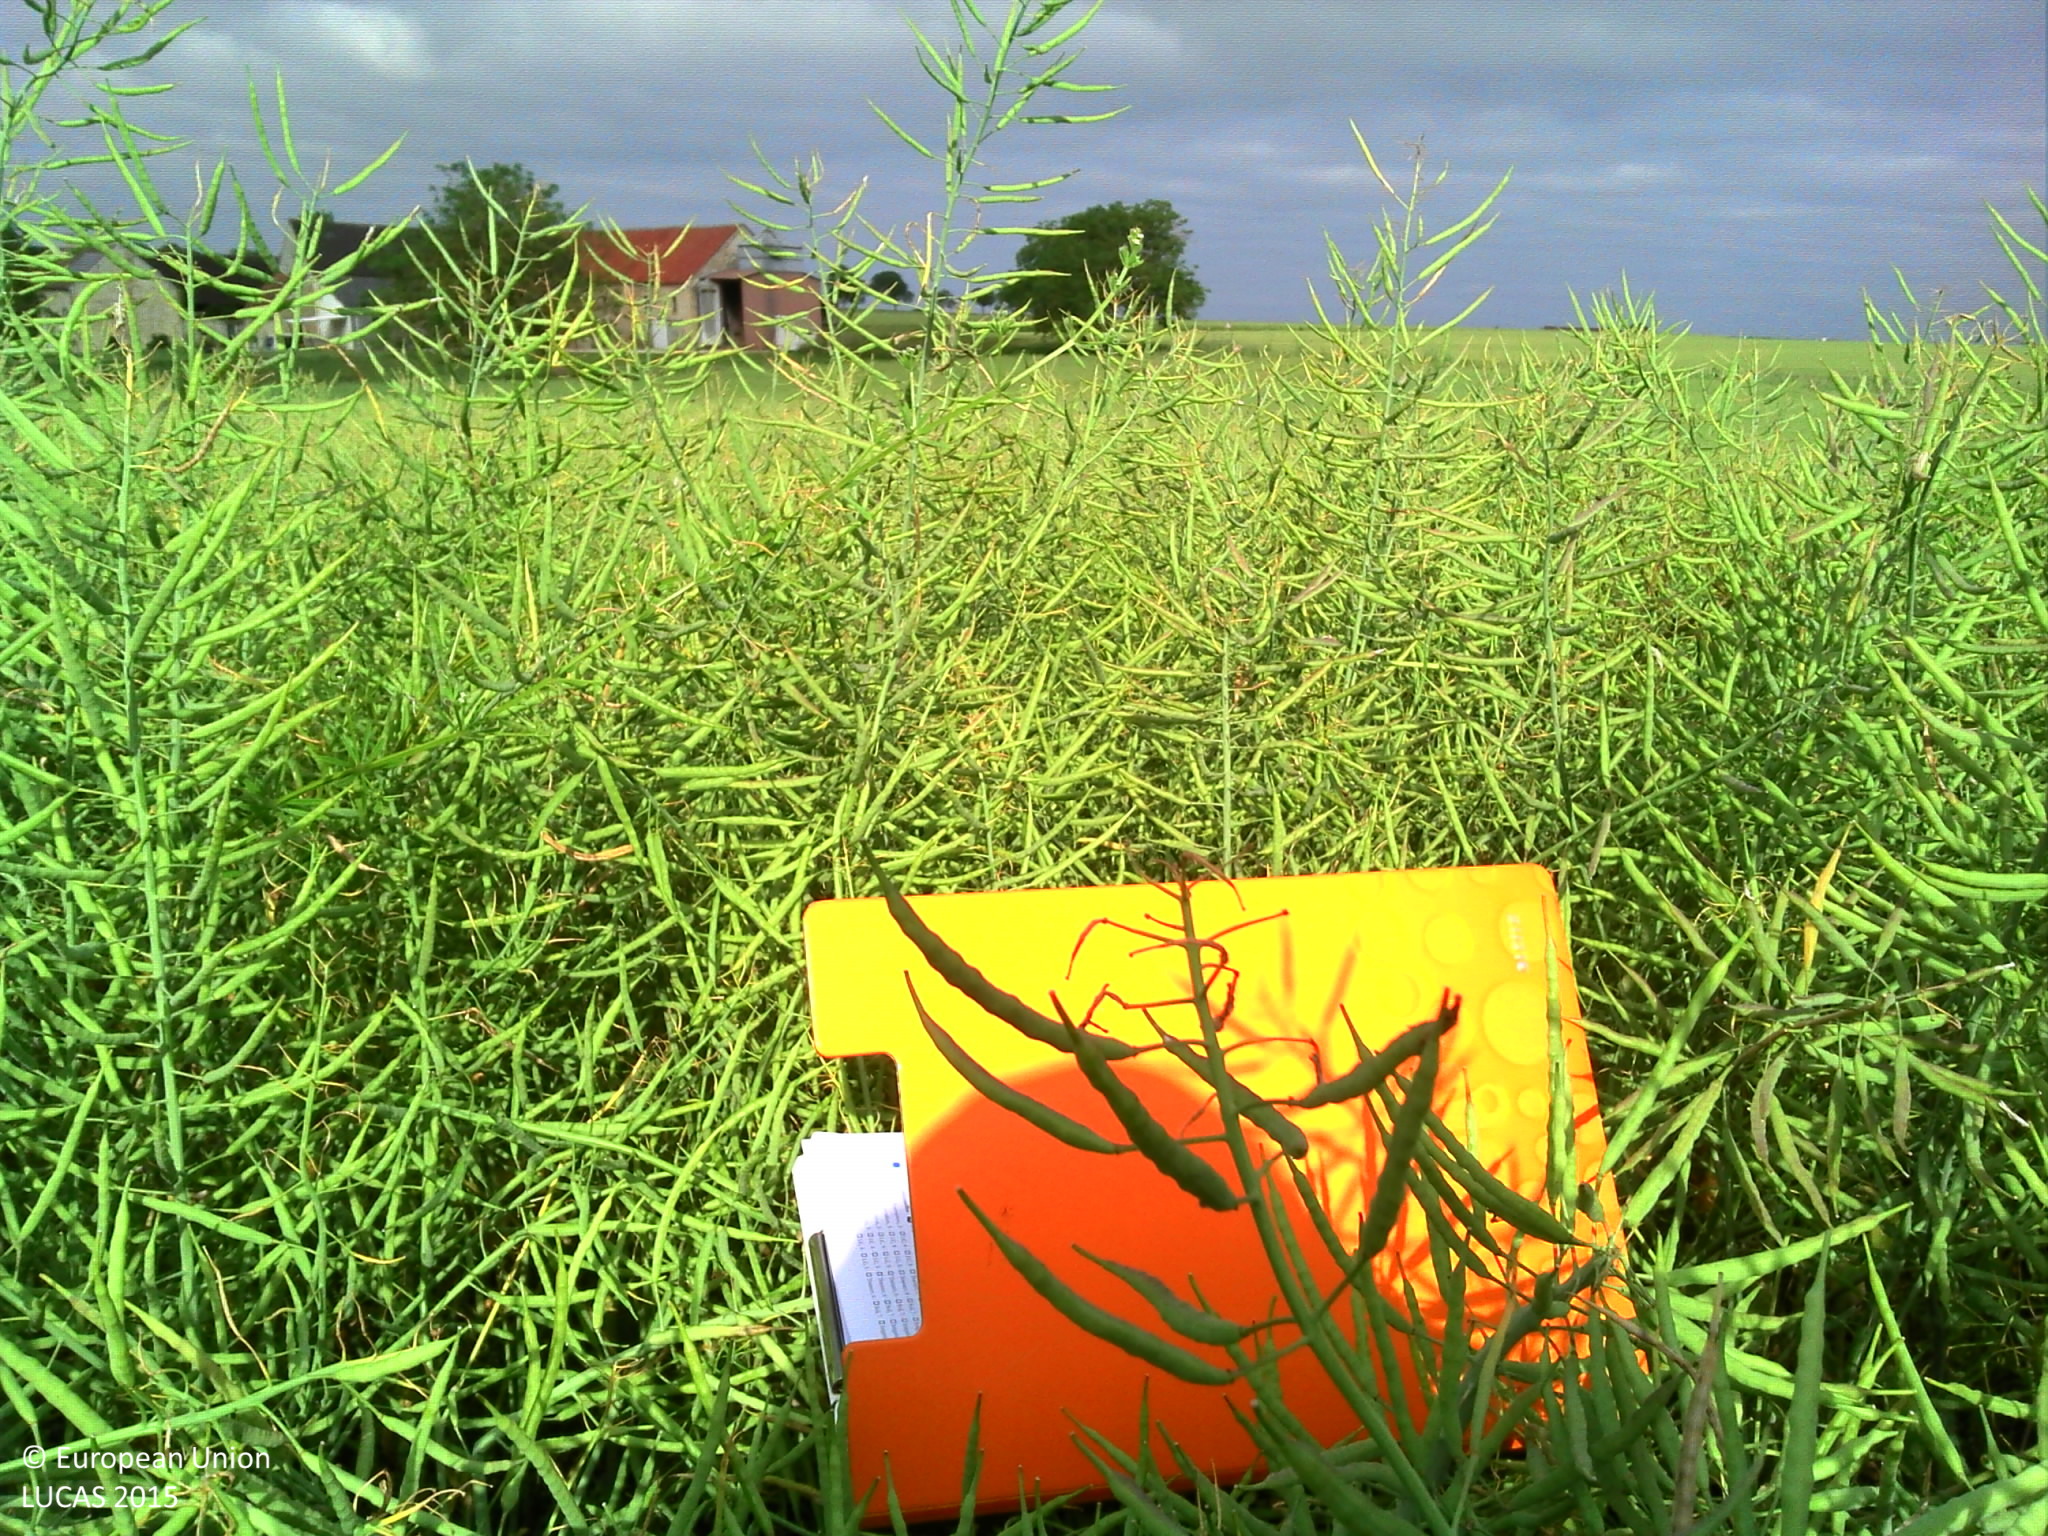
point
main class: Cropland
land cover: Rape and turnip rape
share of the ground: > 75 %
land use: Agriculture (excluding fallow land and kitchen gardens)
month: June
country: FR
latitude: 46.9336
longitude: 2.7047
